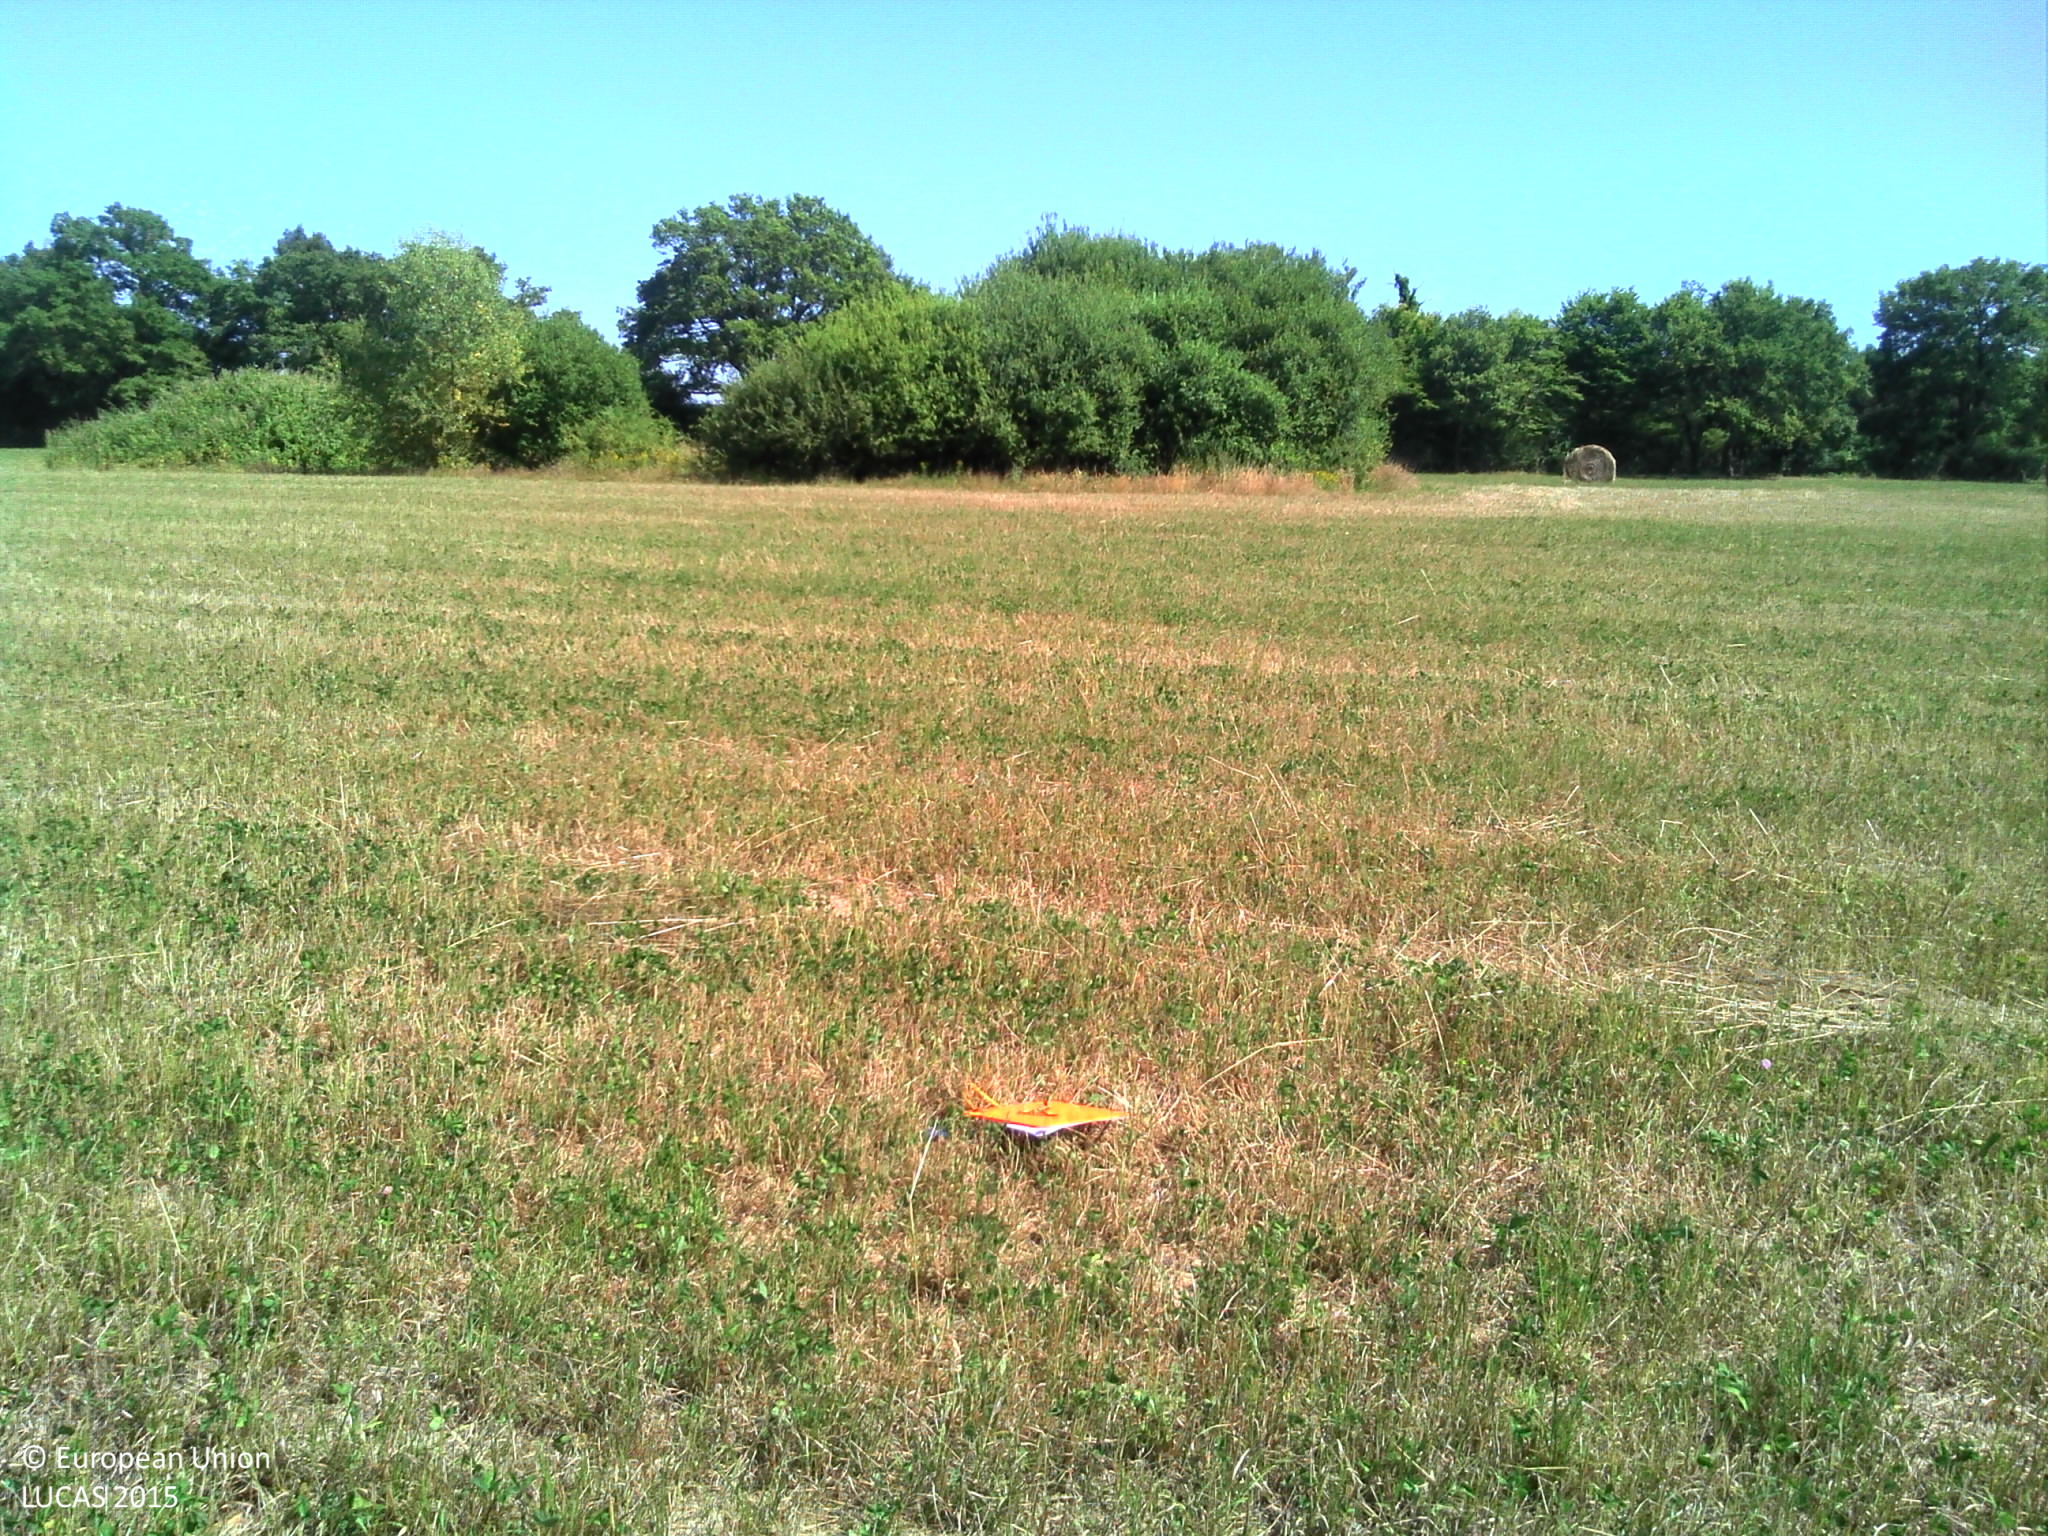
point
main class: Grassland
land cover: Grassland without tree/shrub cover
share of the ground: > 75 %
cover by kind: herbaceous plants 100 %
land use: Agriculture (excluding fallow land and kitchen gardens)
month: June
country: FR
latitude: 47.6494
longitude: 2.8709
